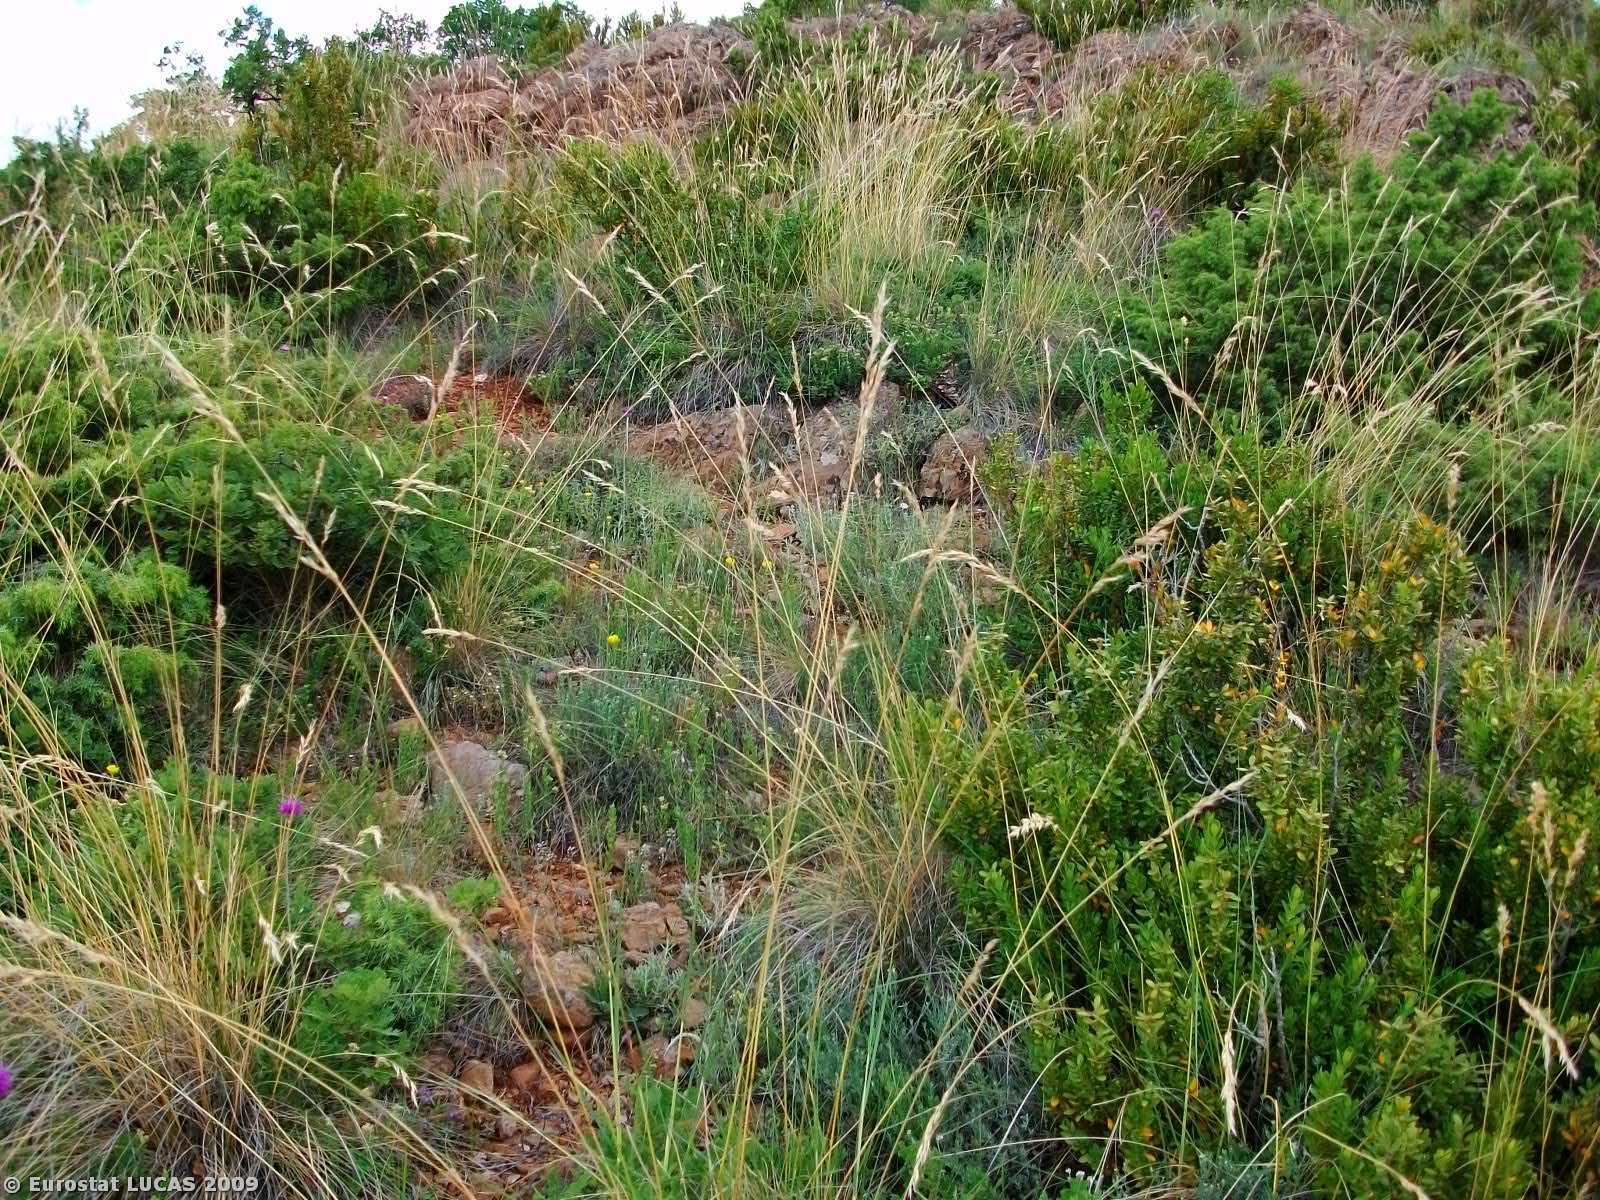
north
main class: Shrubland
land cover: Shrubland with sparse tree cover
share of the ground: > 75 %
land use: Unused
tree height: > 5 m
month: June
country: GR
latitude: 40.0344
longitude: 21.7429
